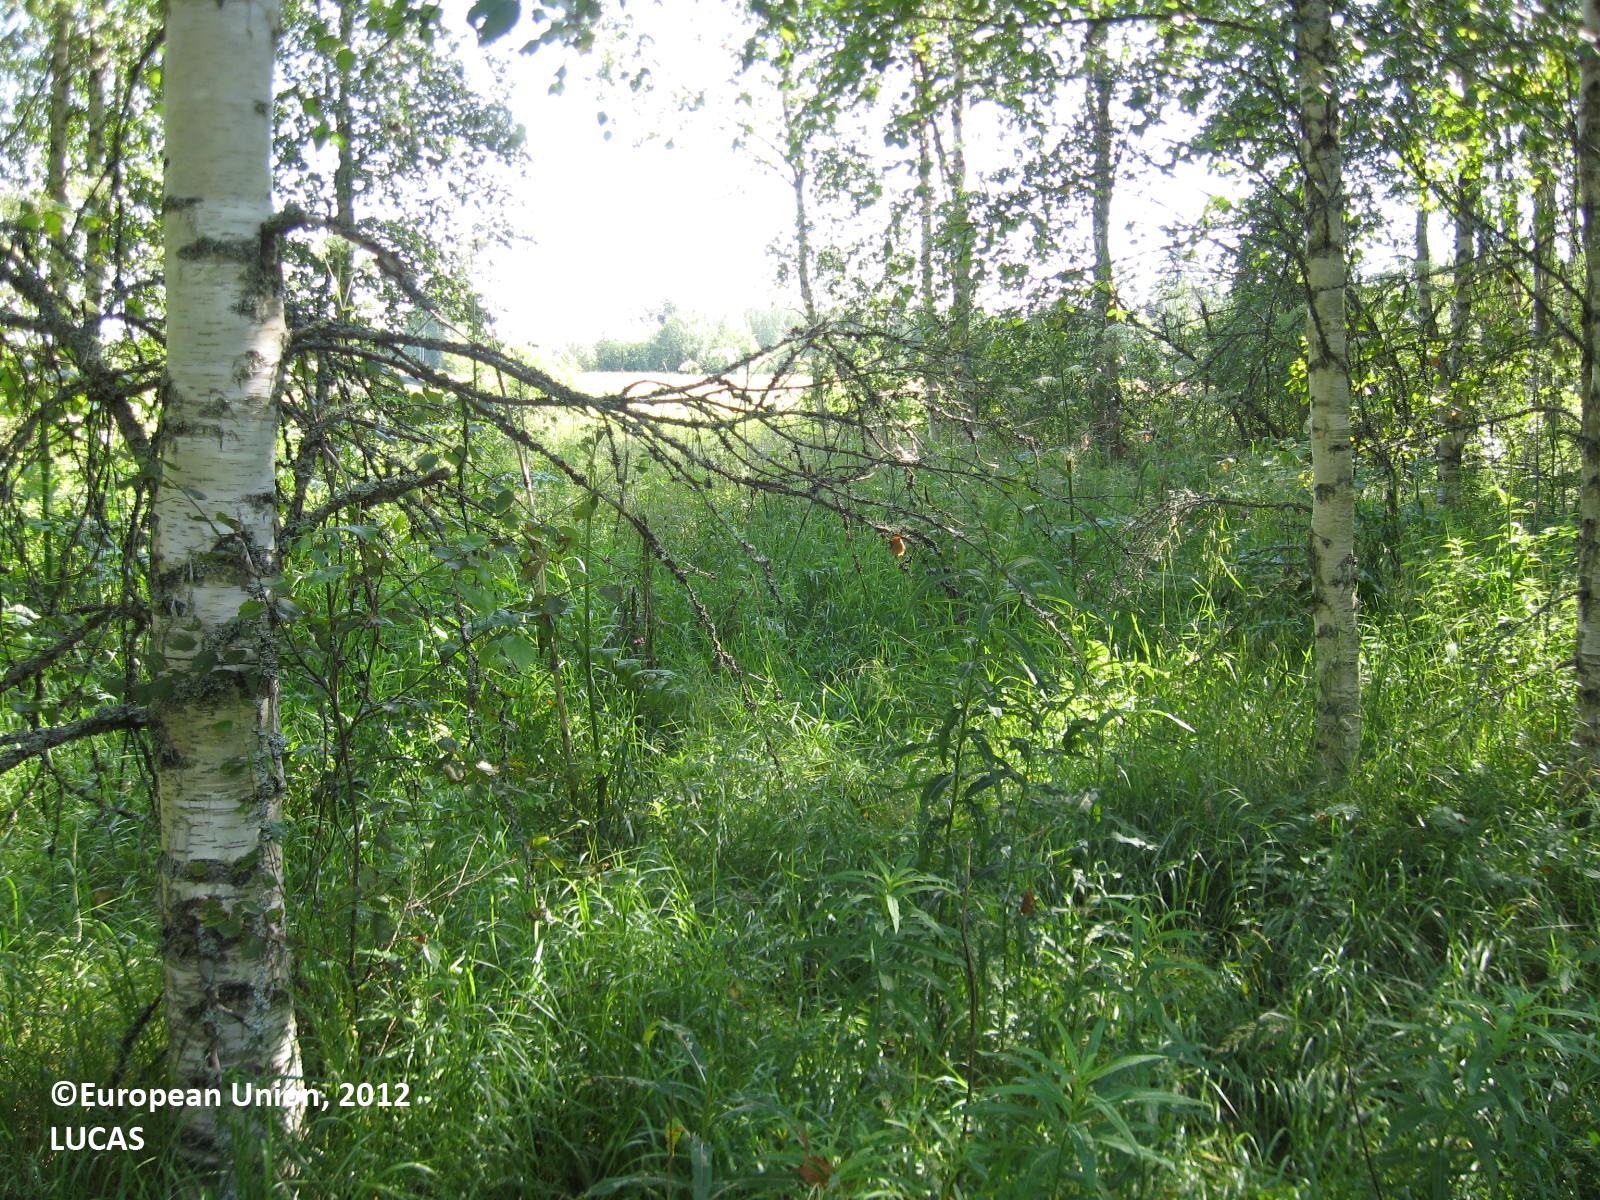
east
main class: Woodland
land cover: Broadleaved woodland
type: boreal forest
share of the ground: > 75 %
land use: Forestry
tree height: > 5 m
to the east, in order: Broadleaved woodland; Grassland with sparse tree/shrub cover; Ditches and canals; Mixed cereals for fodder; Ditches and canals; Broadleaved woodland; Ditches and canals; Shruby margins; Tracks; Shruby margins; Ditches and canals; Other bare soil
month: July
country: FI
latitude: 61.8700
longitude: 22.7072
